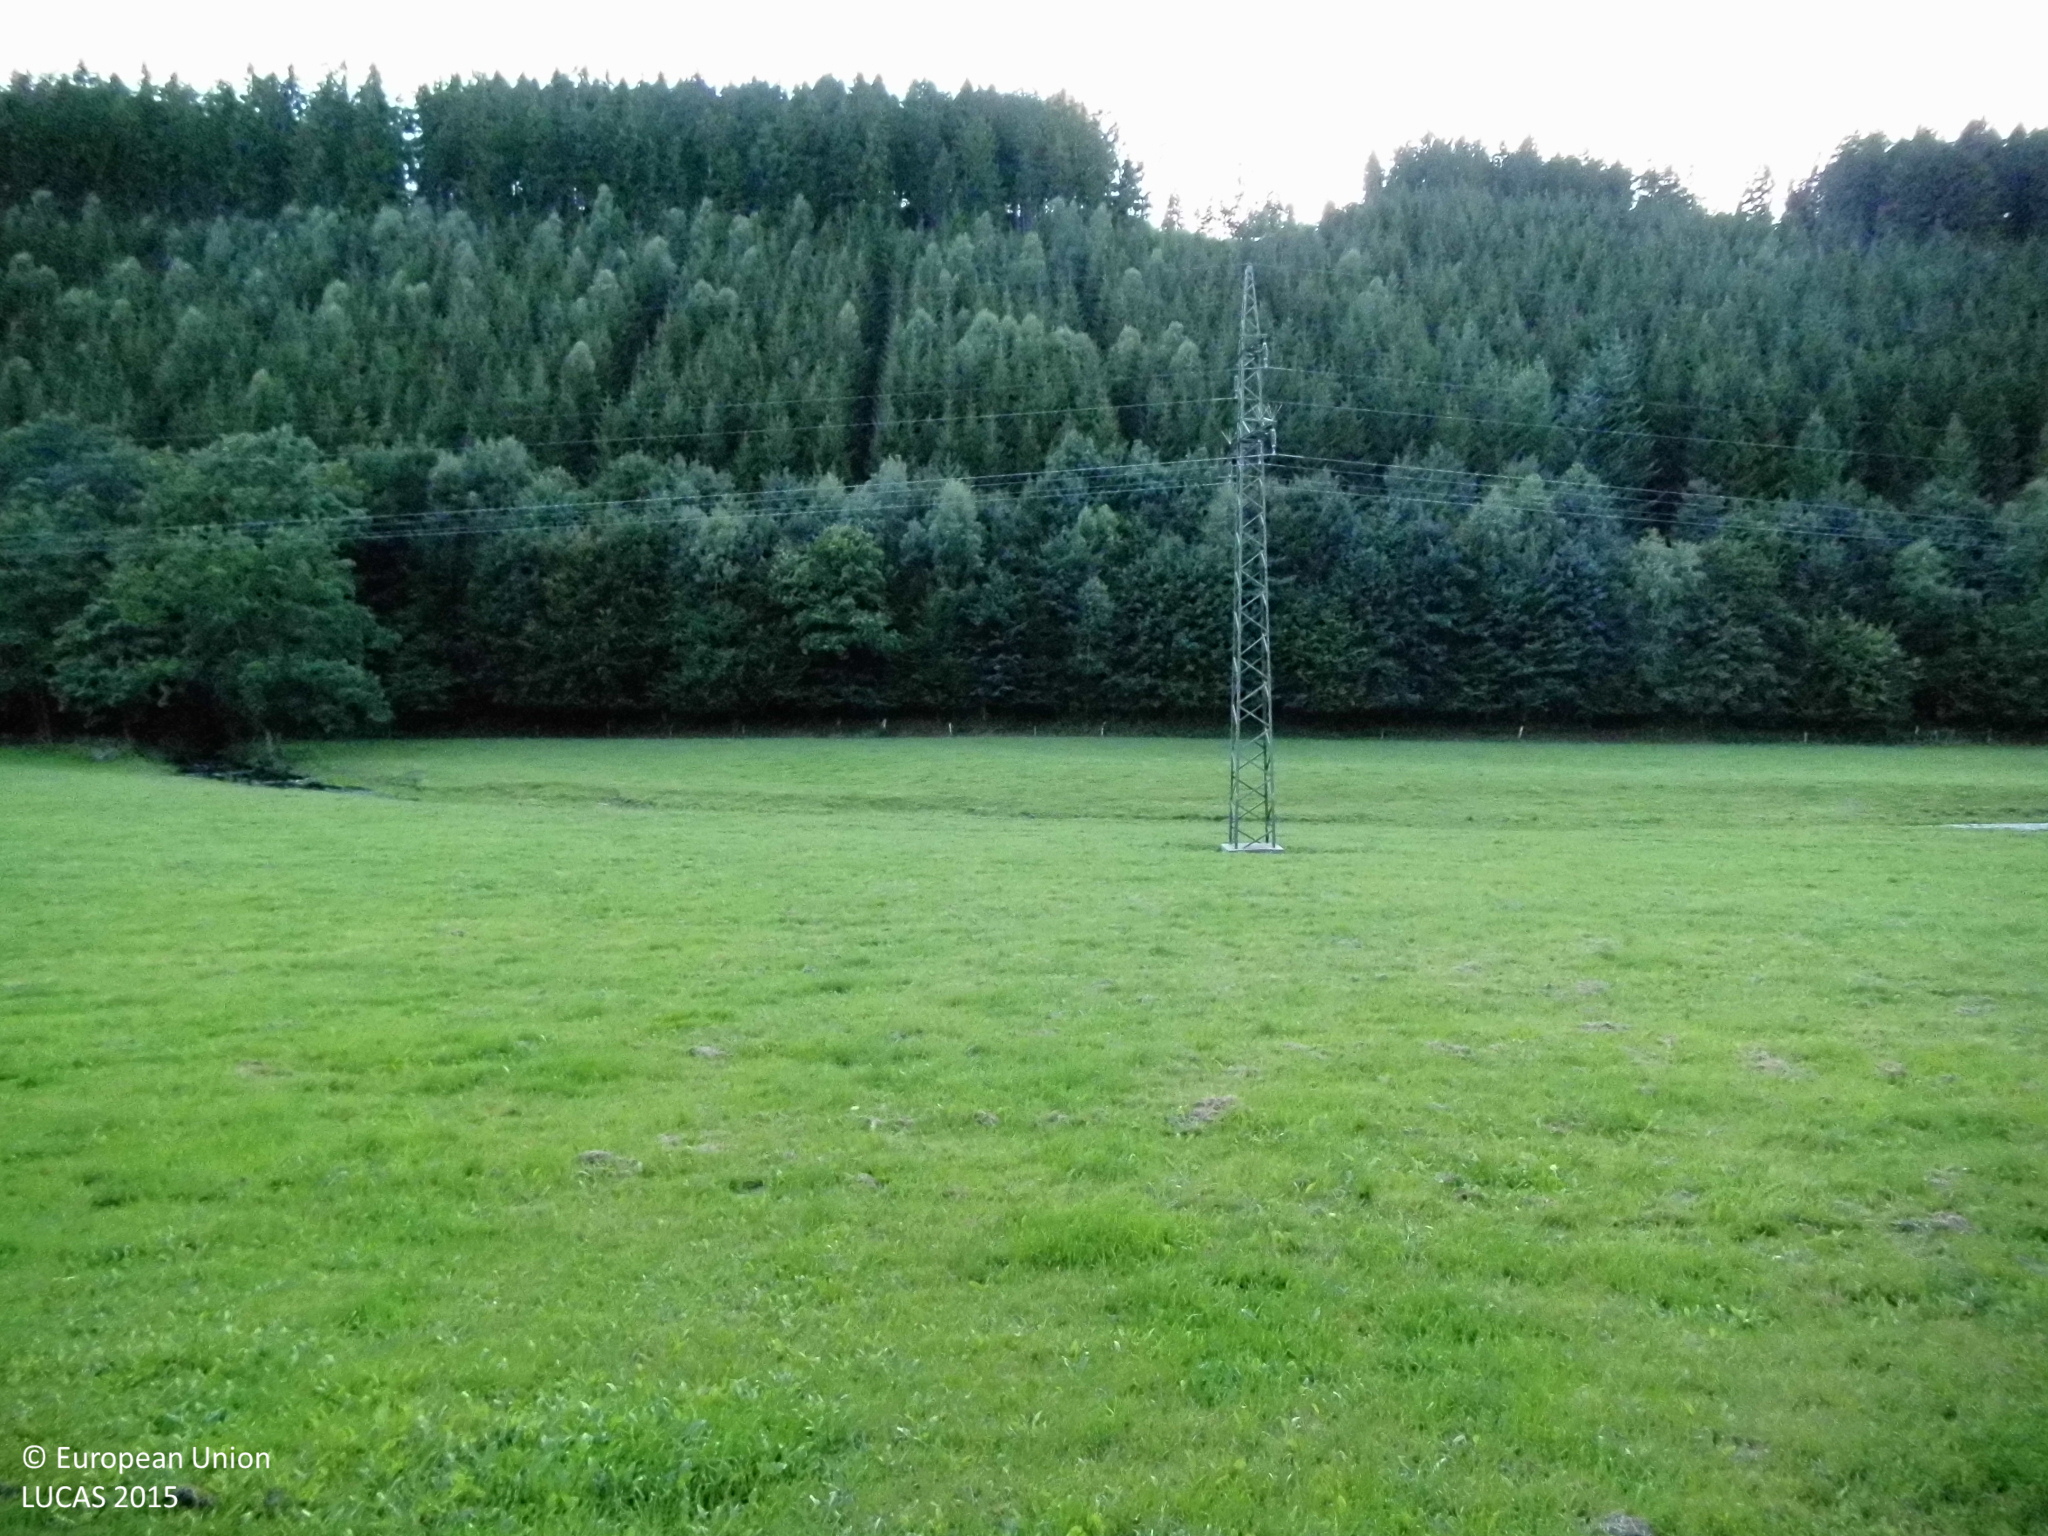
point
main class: Grassland
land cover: Grassland without tree/shrub cover
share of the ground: > 75 %
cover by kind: herbaceous plants 100 %
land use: Agriculture (excluding fallow land and kitchen gardens)
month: September
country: DE
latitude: 51.3252
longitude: 8.4936
